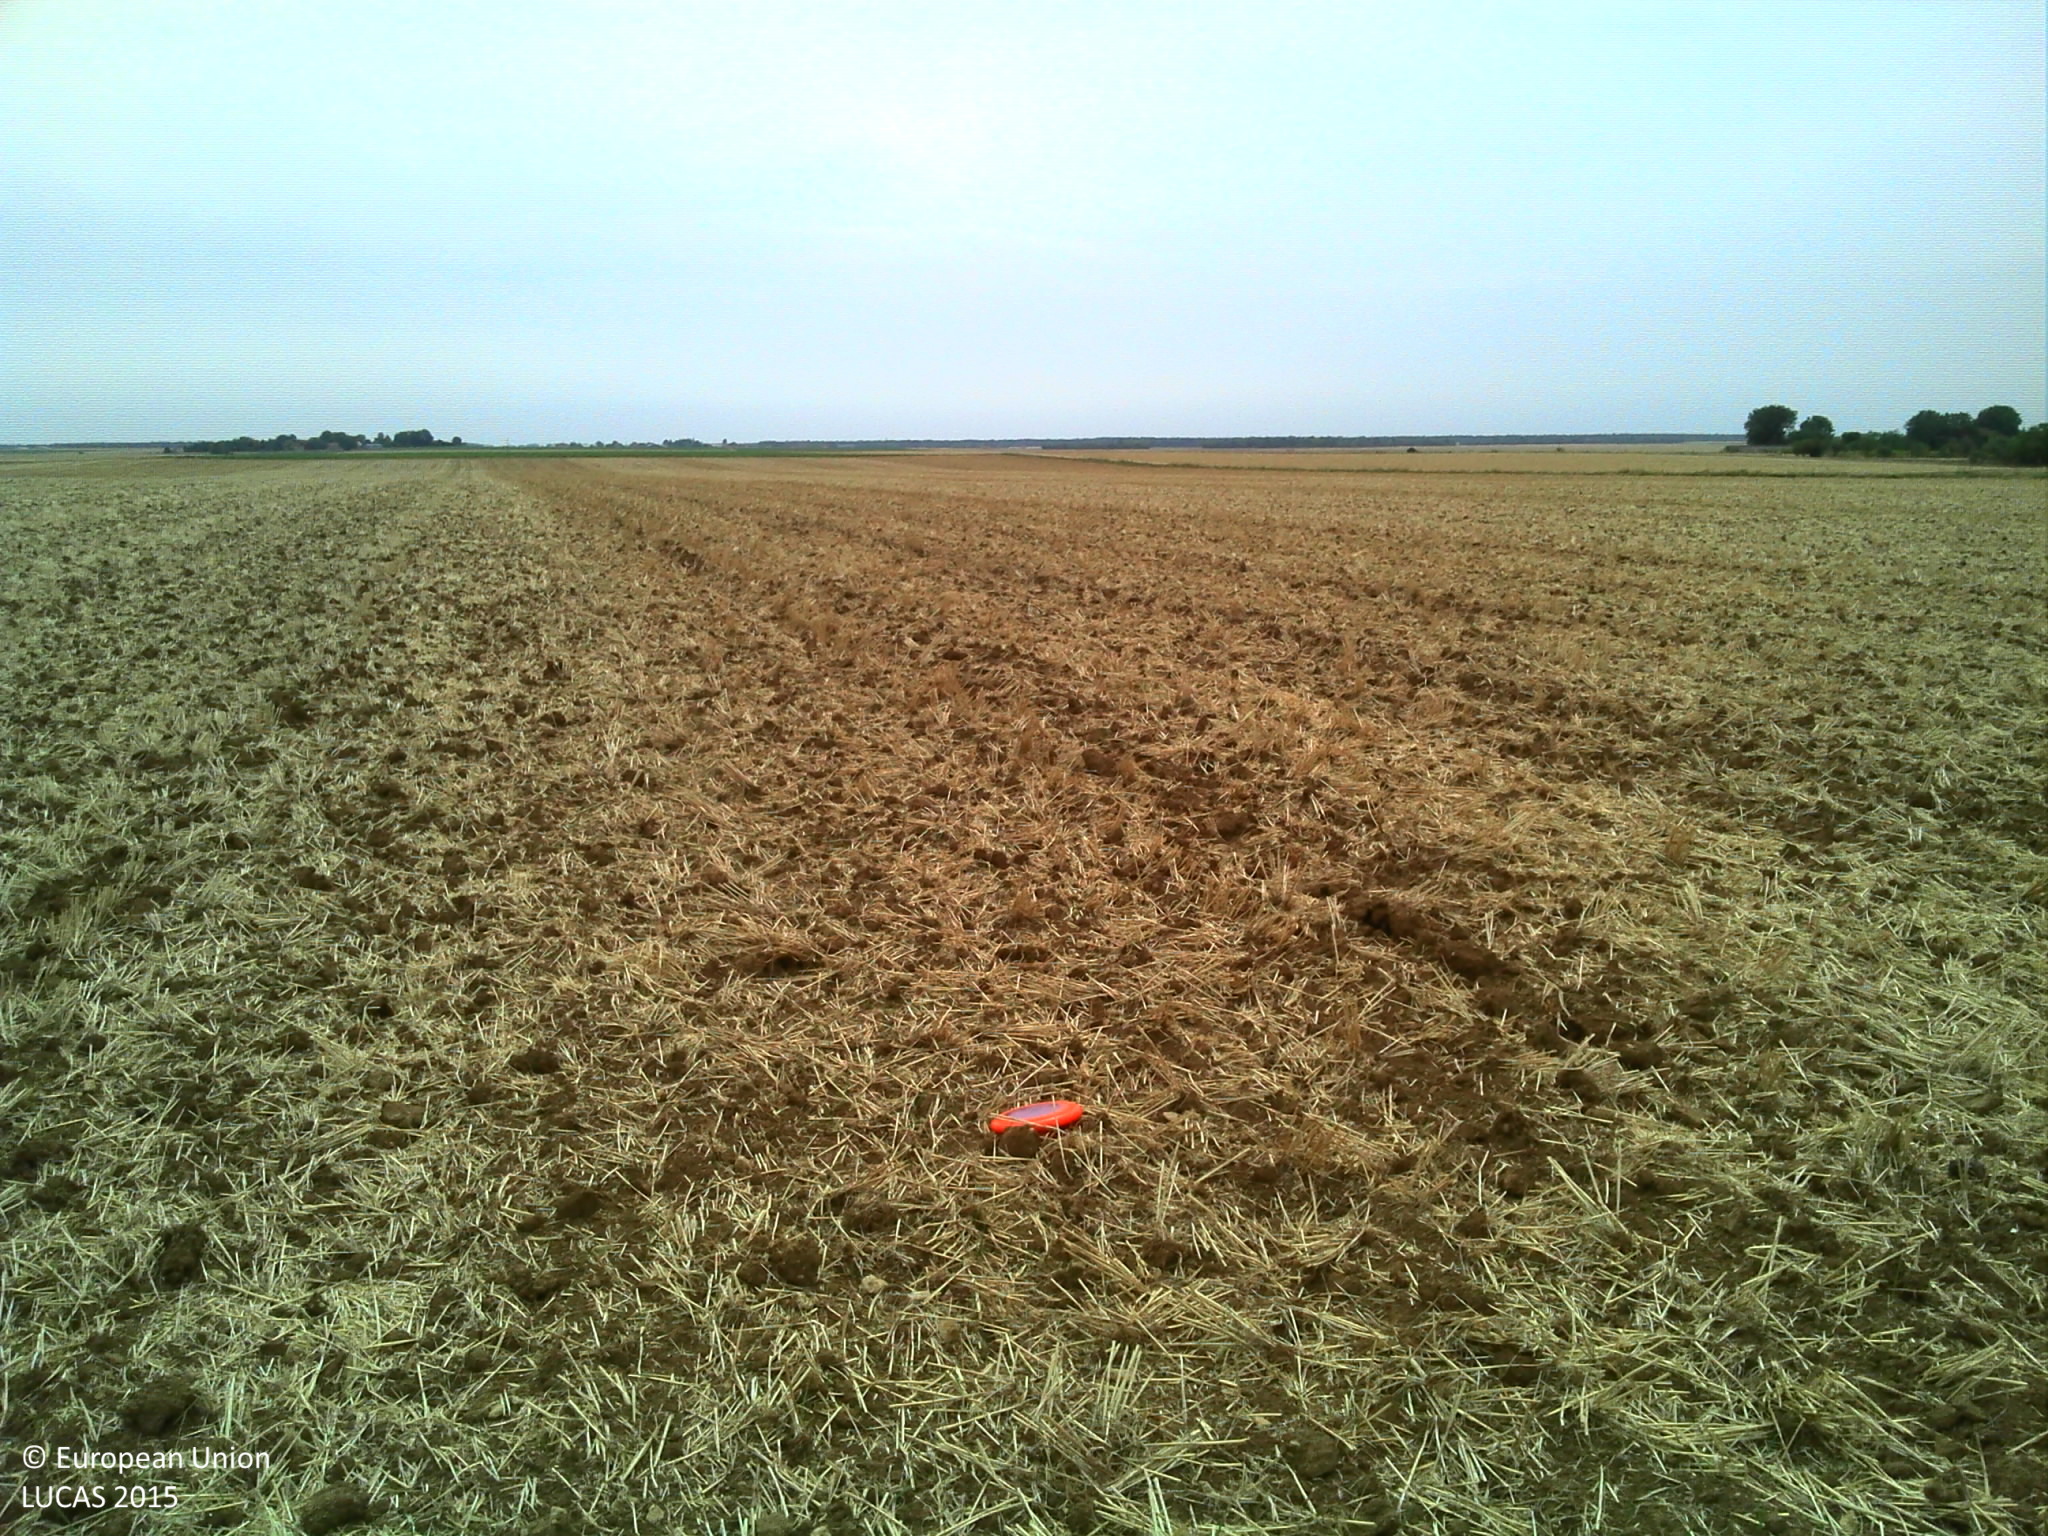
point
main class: Cropland
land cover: Common wheat
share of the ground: 25 - 50 %
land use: Agriculture (excluding fallow land and kitchen gardens)
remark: Harvested field
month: August
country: FR
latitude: 48.2061
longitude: 2.5490
